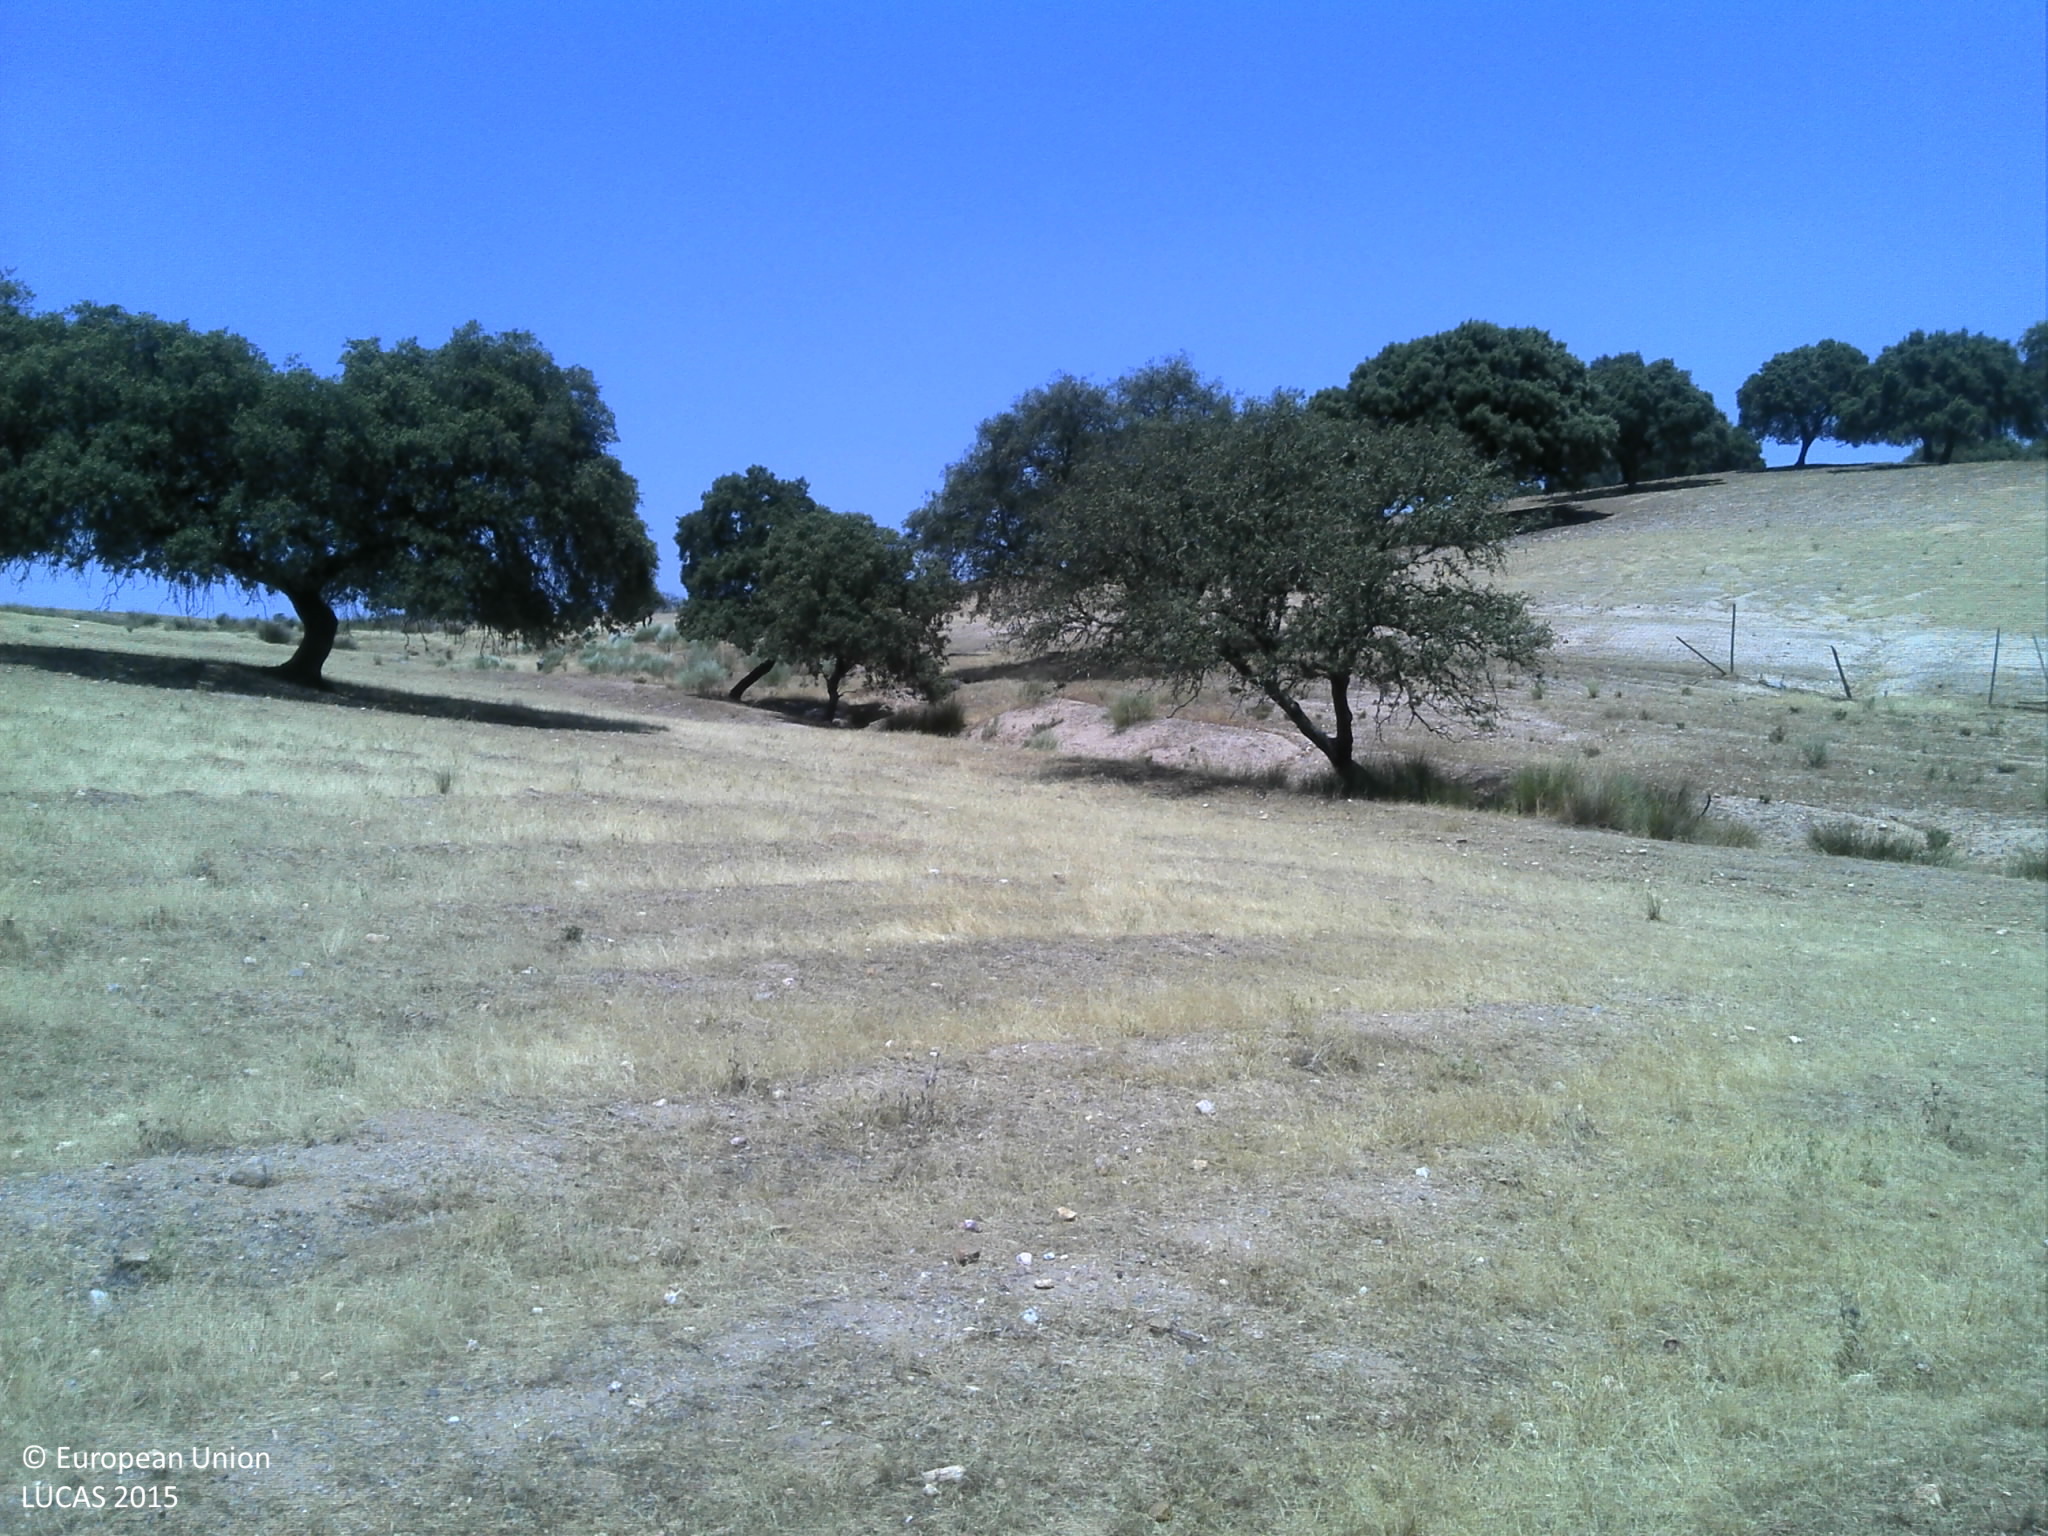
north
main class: Grassland
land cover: Grassland without tree/shrub cover
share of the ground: 25 - 50 %
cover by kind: herbaceous plants 45 %, unconsolidated bare surface 45 %, shrubs 5 %
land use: Agriculture (excluding fallow land and kitchen gardens)
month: June
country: PT
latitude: 39.7602
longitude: -7.1432
